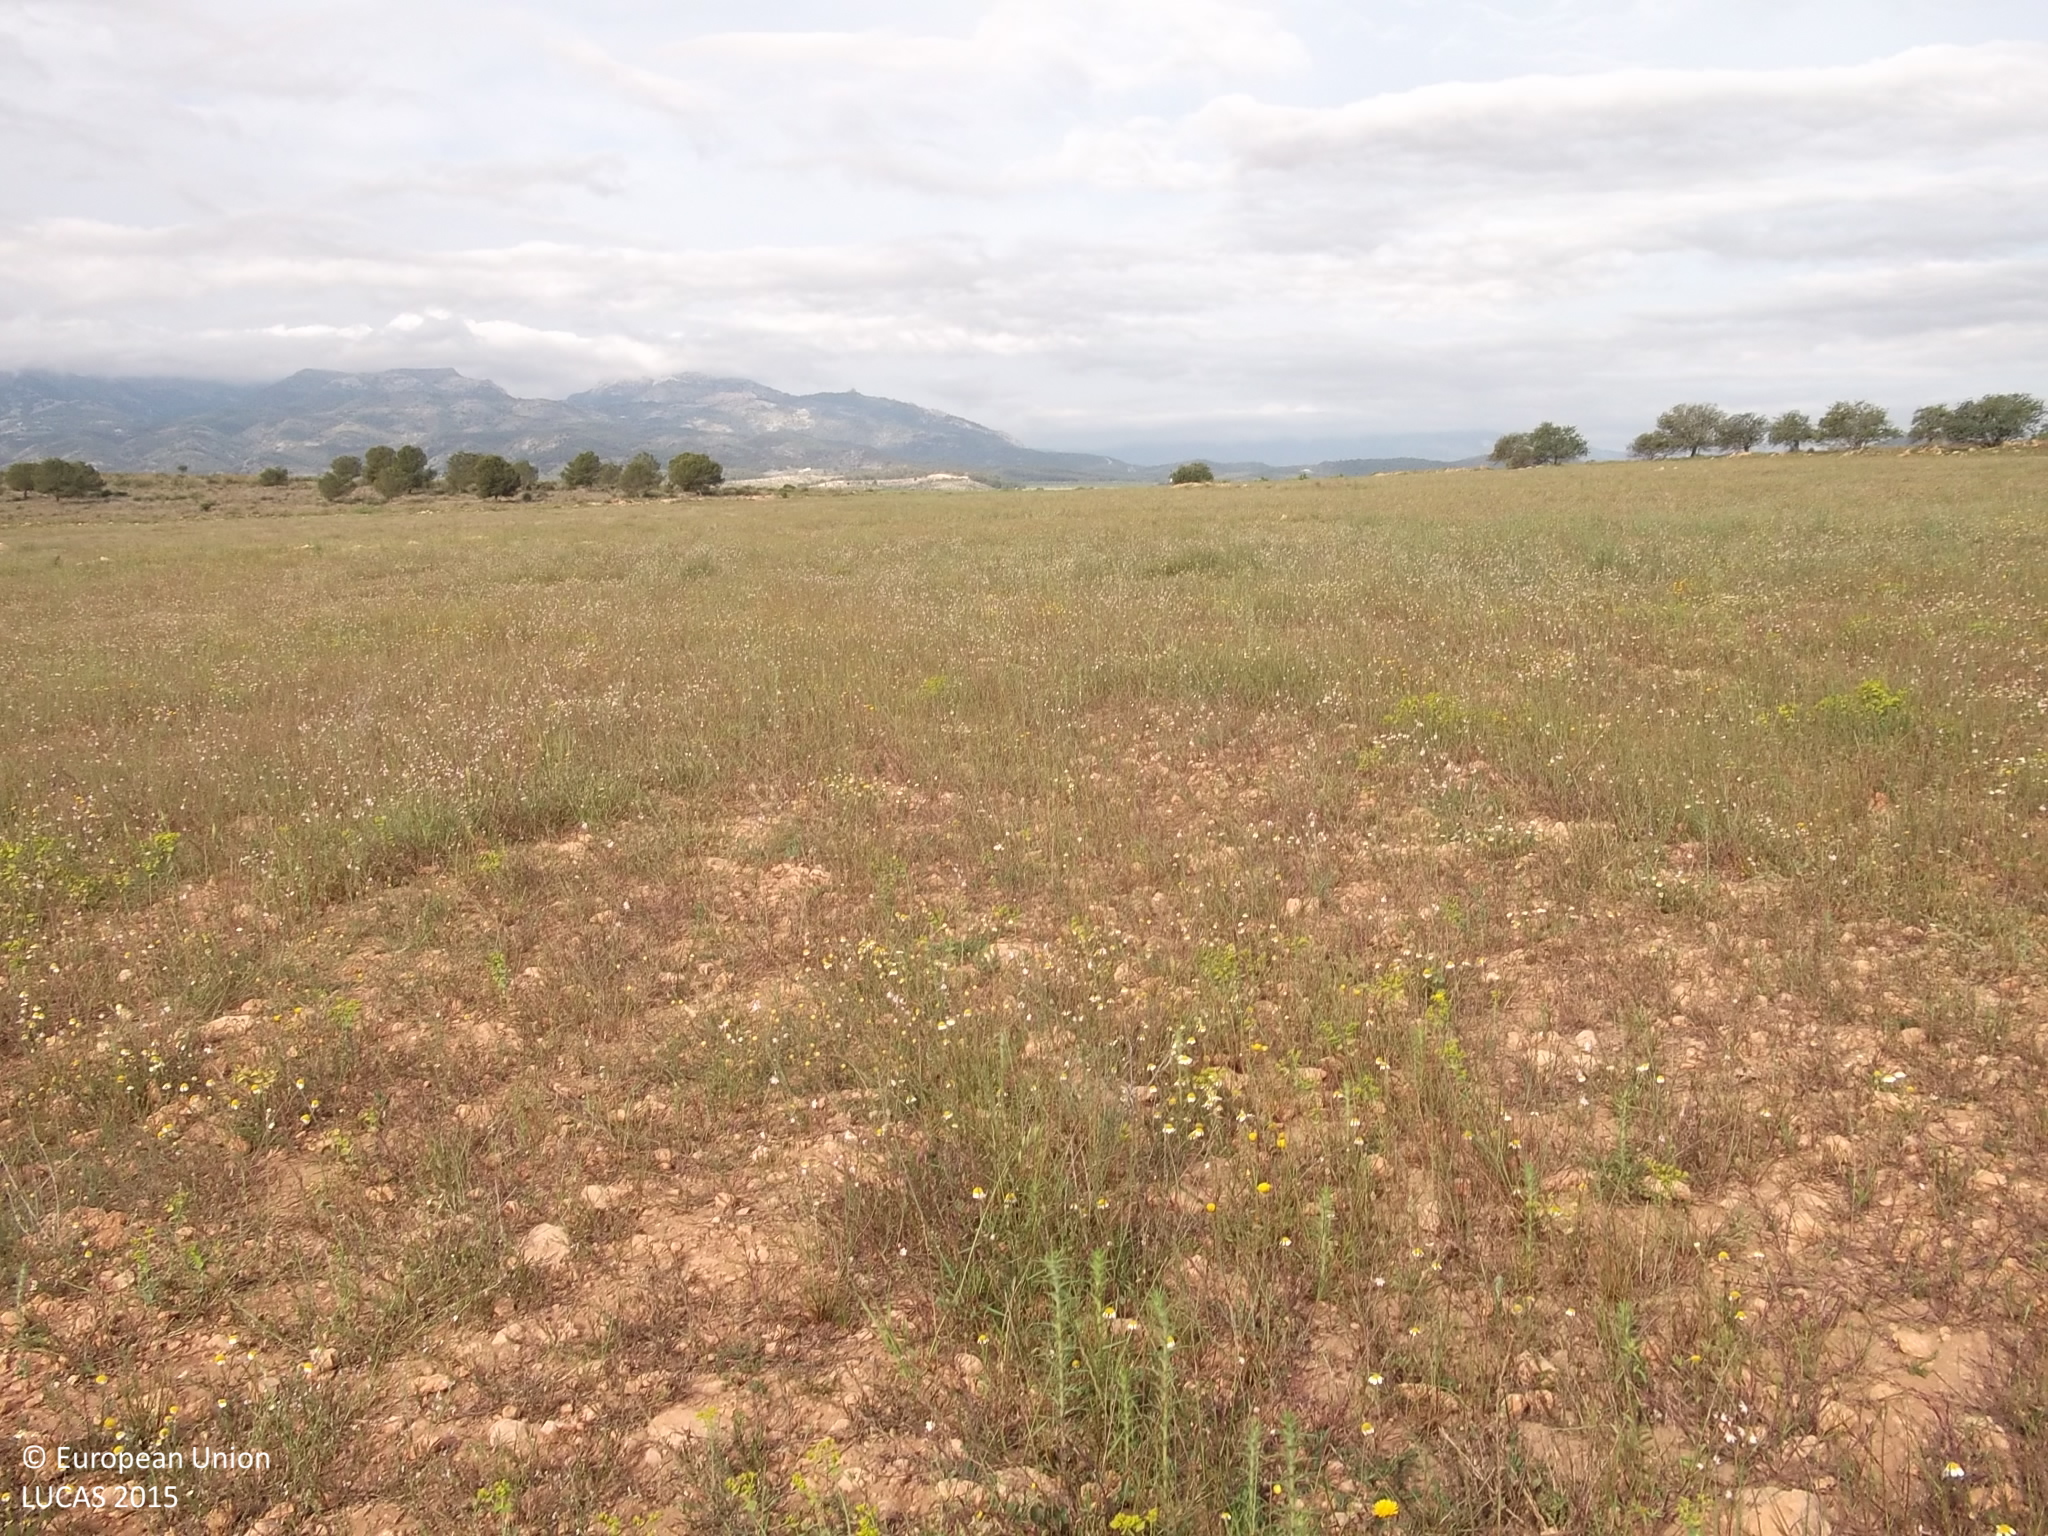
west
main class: Grassland
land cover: Spontaneously vegetated surfaces
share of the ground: 50 - 75 %
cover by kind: herbaceous plants 75 %, unconsolidated bare surface 25 %
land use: Fallow land
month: April
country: ES
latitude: 37.9534
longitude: -1.4225
